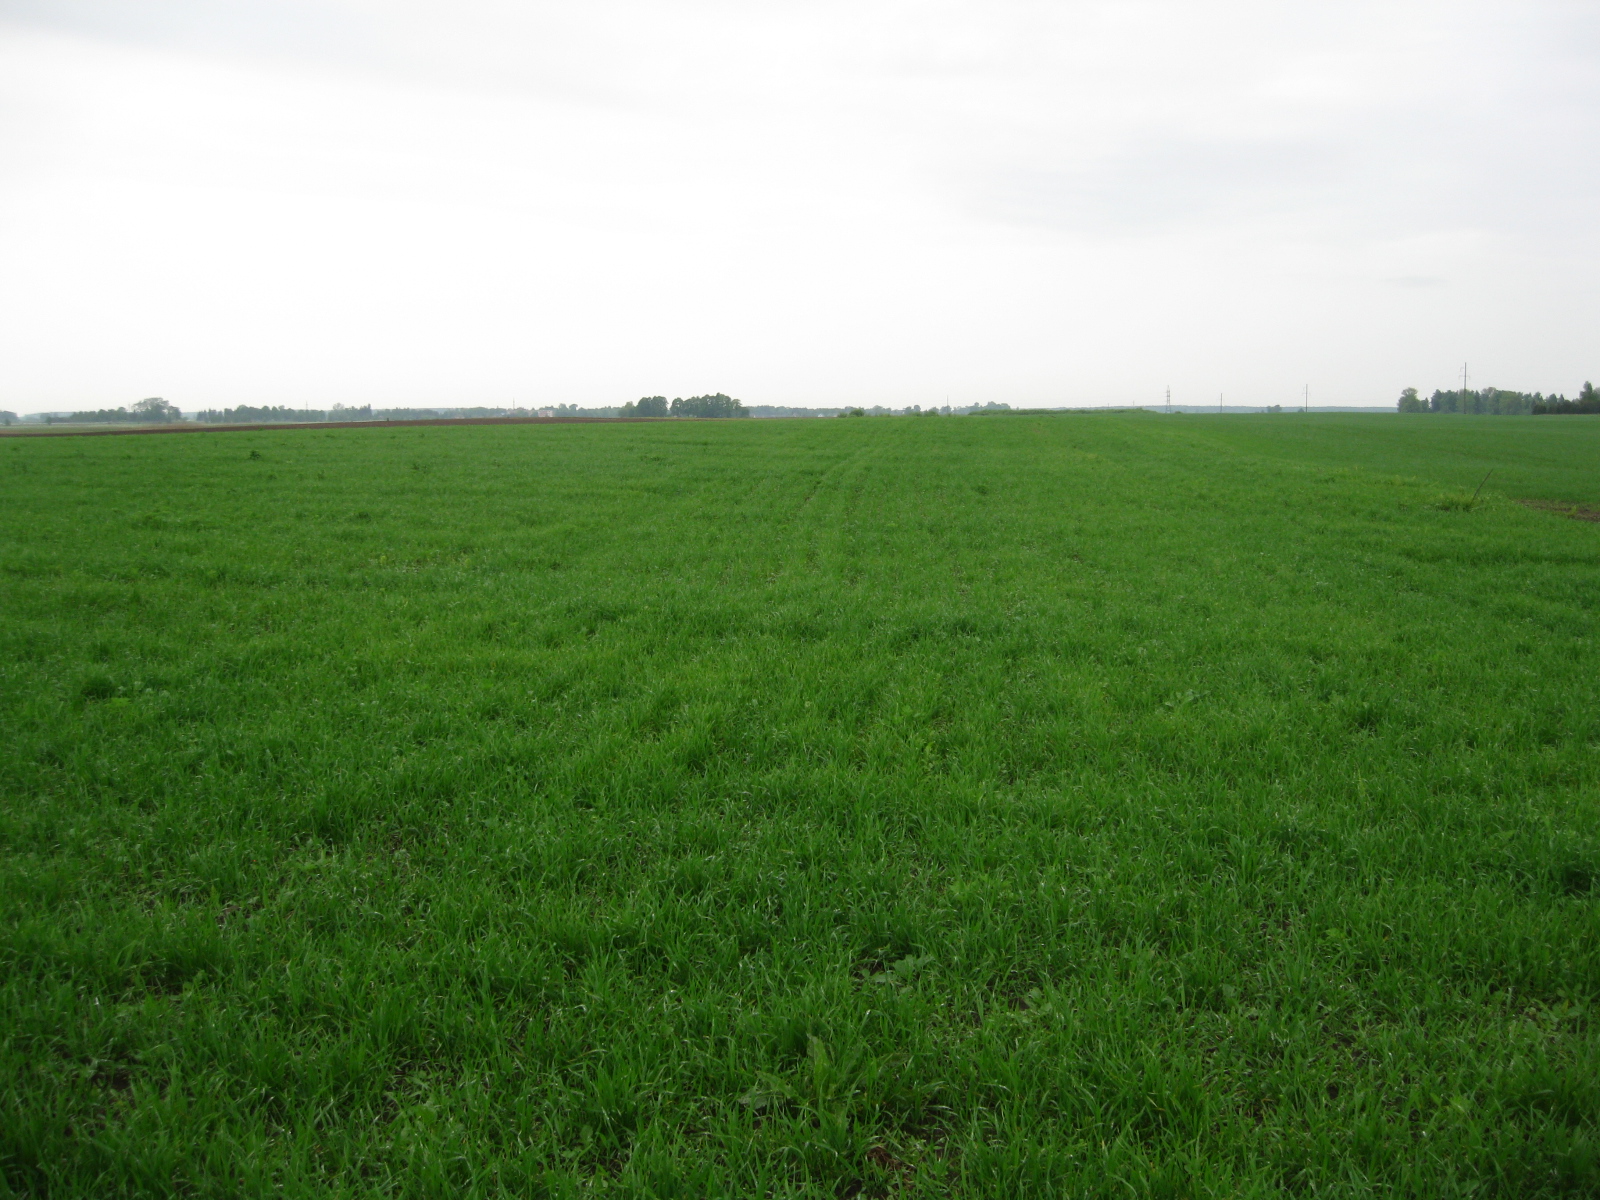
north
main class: Cropland
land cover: Common wheat
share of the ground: > 75 %
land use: Agriculture (excluding fallow land and kitchen gardens)
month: May
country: LT
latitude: 55.9062
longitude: 24.3475
